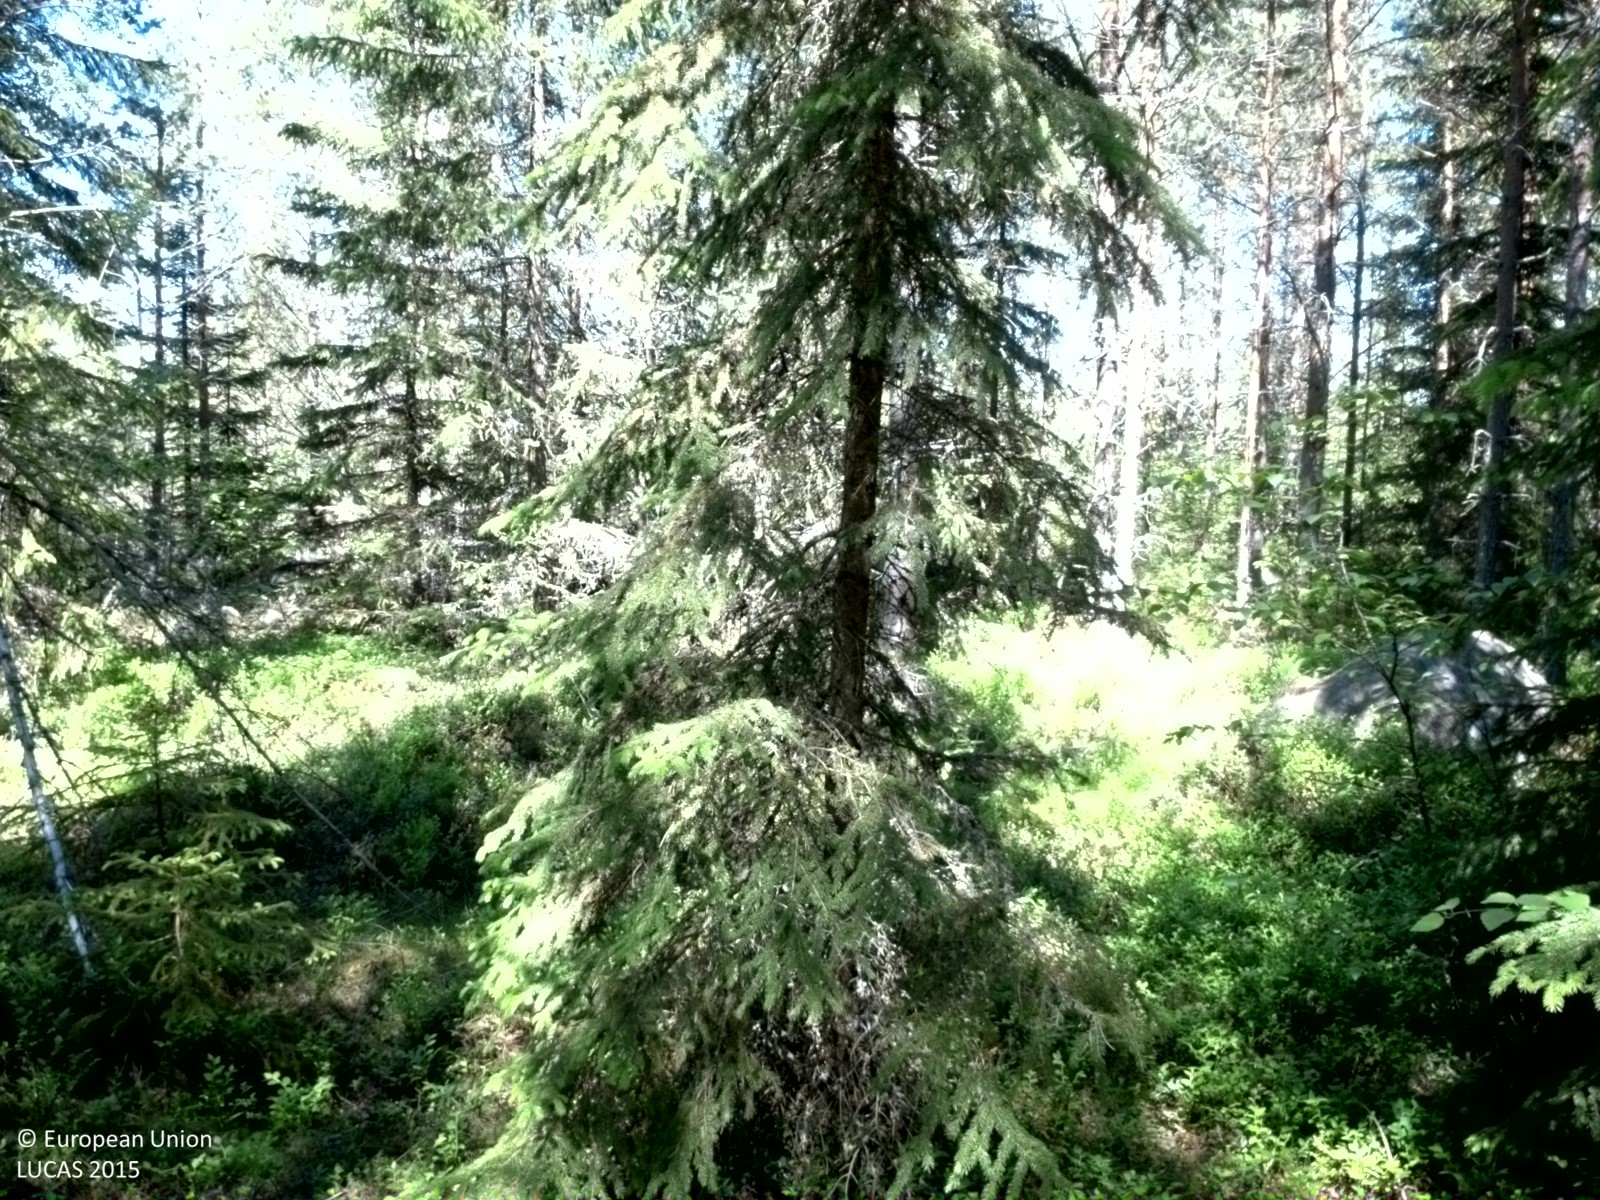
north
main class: Woodland
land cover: Pine dominated coniferous woodland
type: boreal forest
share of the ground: > 75 %
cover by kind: coniferous forest trees 70 %, broadleaved forest trees 10 %, shrubs 10 %, herbaceous plants 5 %, consolidated bare surface 5 %
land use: Forestry
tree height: > 5 m
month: June
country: SE
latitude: 60.2095
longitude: 17.6255
